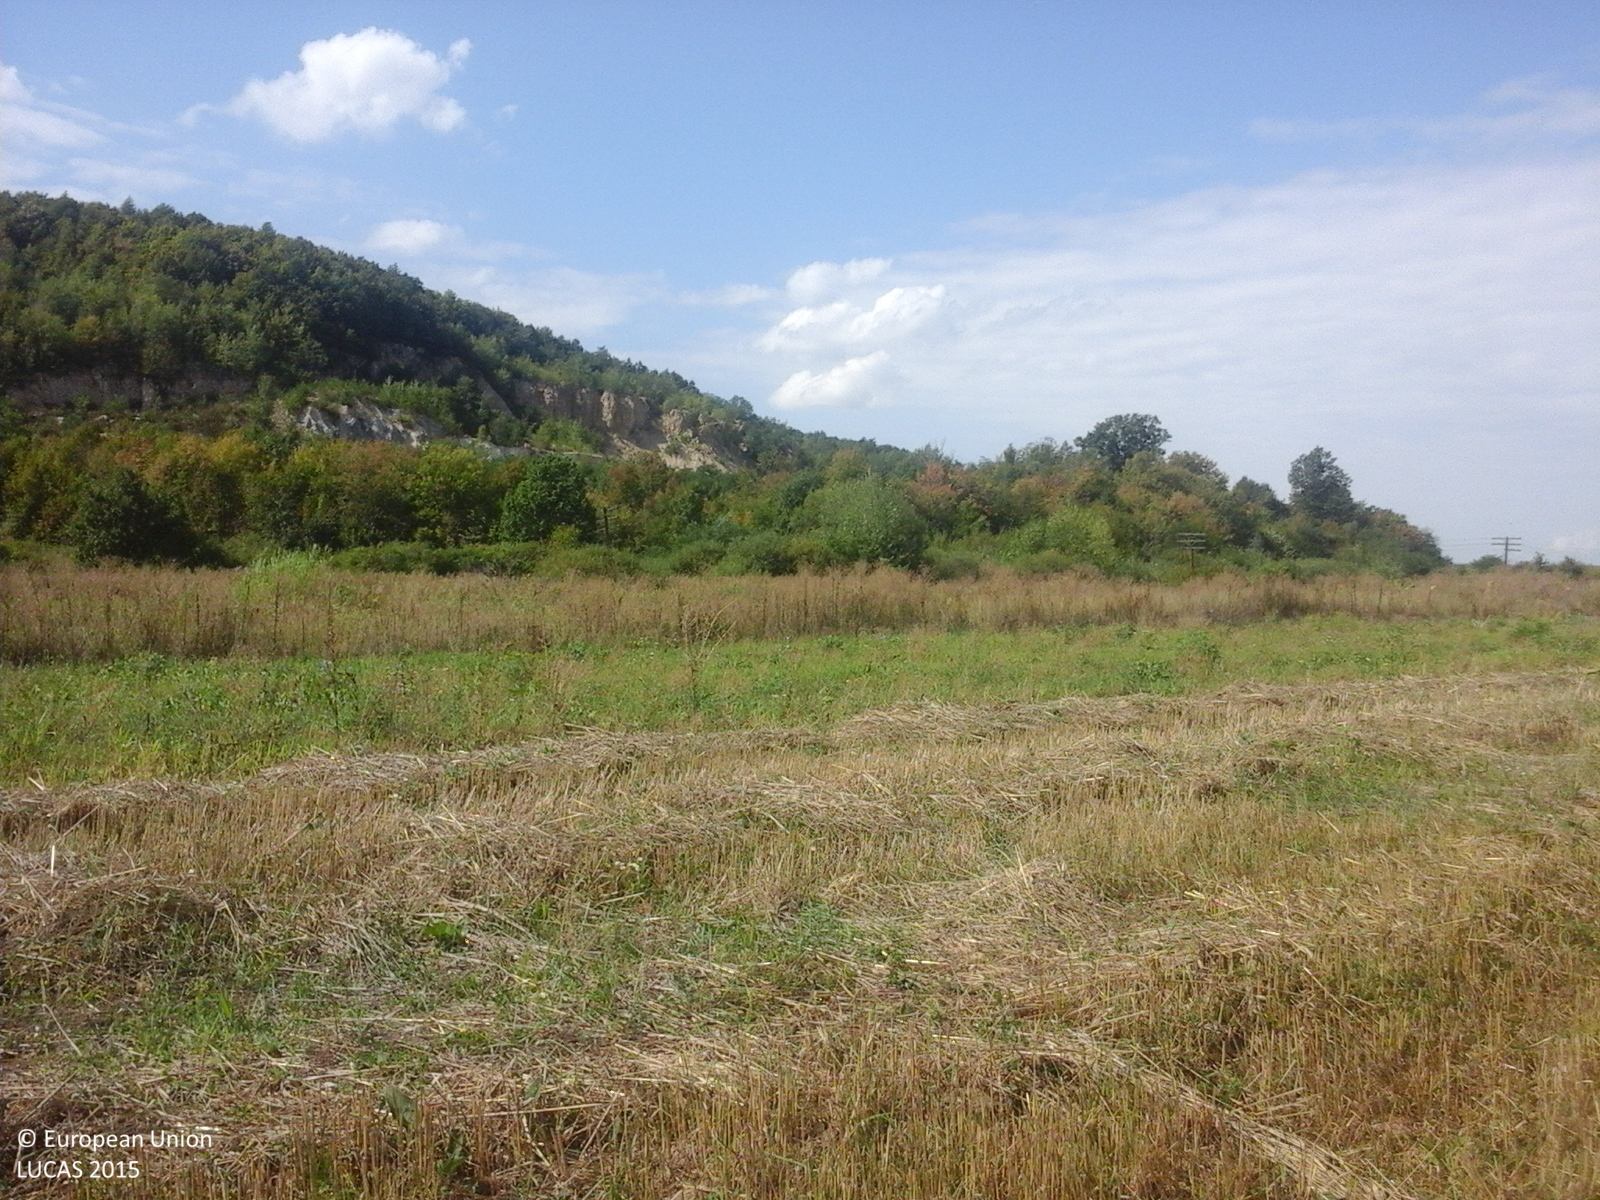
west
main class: Cropland
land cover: Common wheat
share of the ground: > 75 %
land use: Agriculture (excluding fallow land and kitchen gardens)
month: September
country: RO
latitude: 47.8554
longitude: 23.2632
